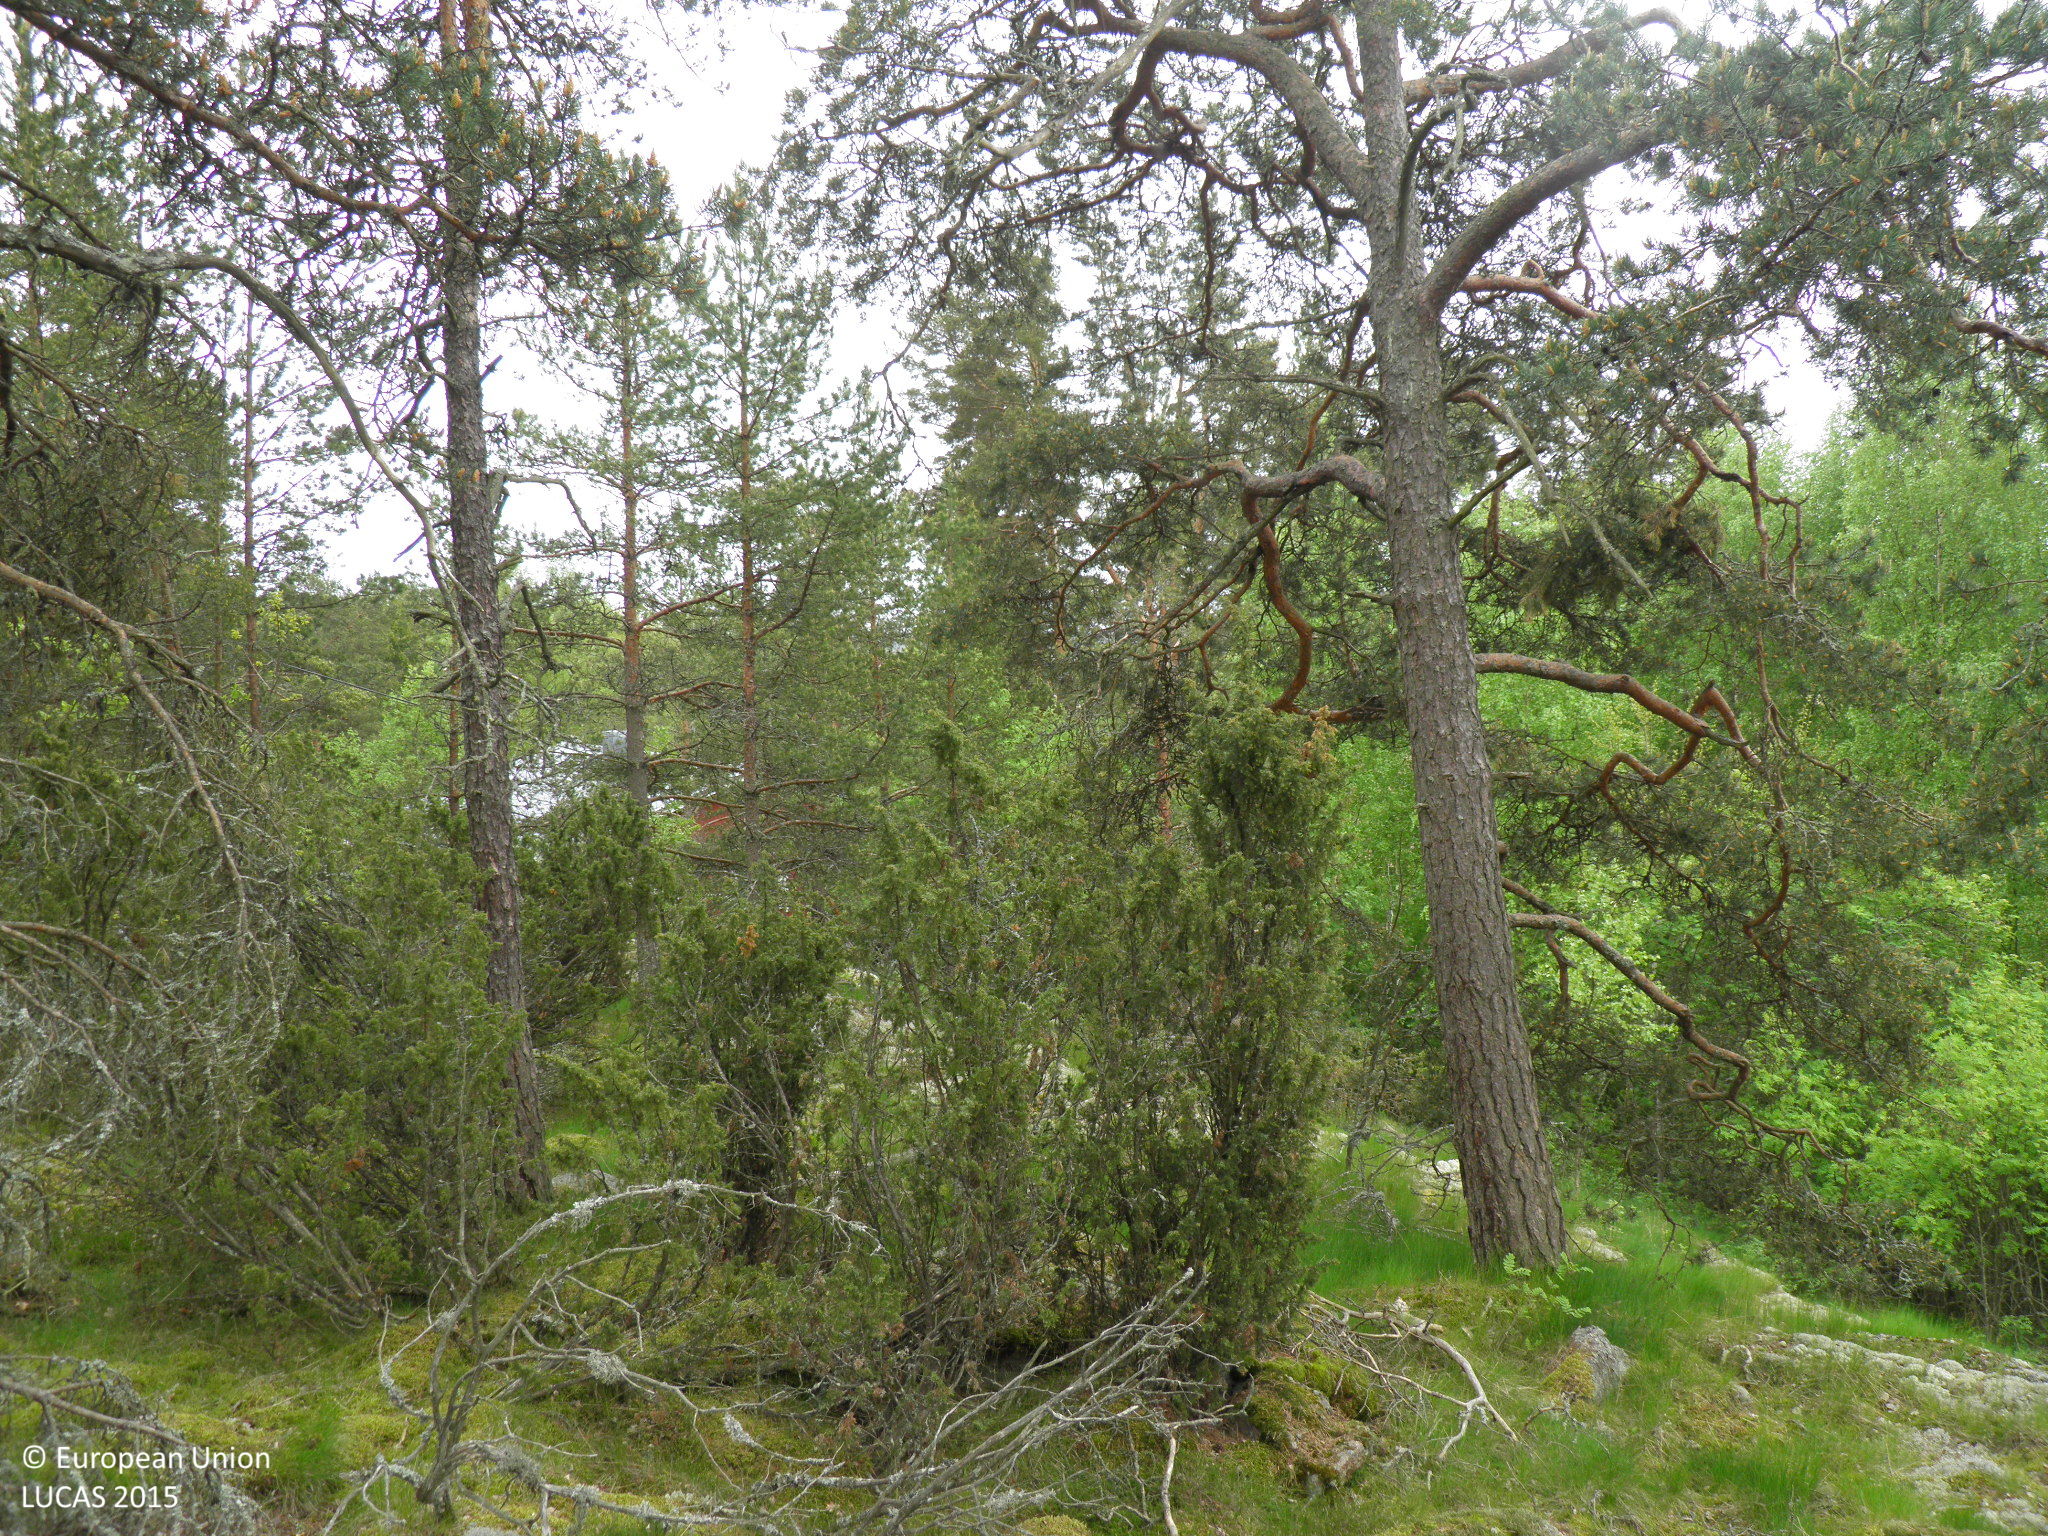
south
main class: Woodland
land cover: Pine dominated coniferous woodland
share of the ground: > 75 %
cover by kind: coniferous forest trees 80 %, broadleaved forest trees 10 %, shrubs 5 %, herbaceous plants 5 %
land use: Forestry
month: June
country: FI
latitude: 60.5108
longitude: 22.3609
